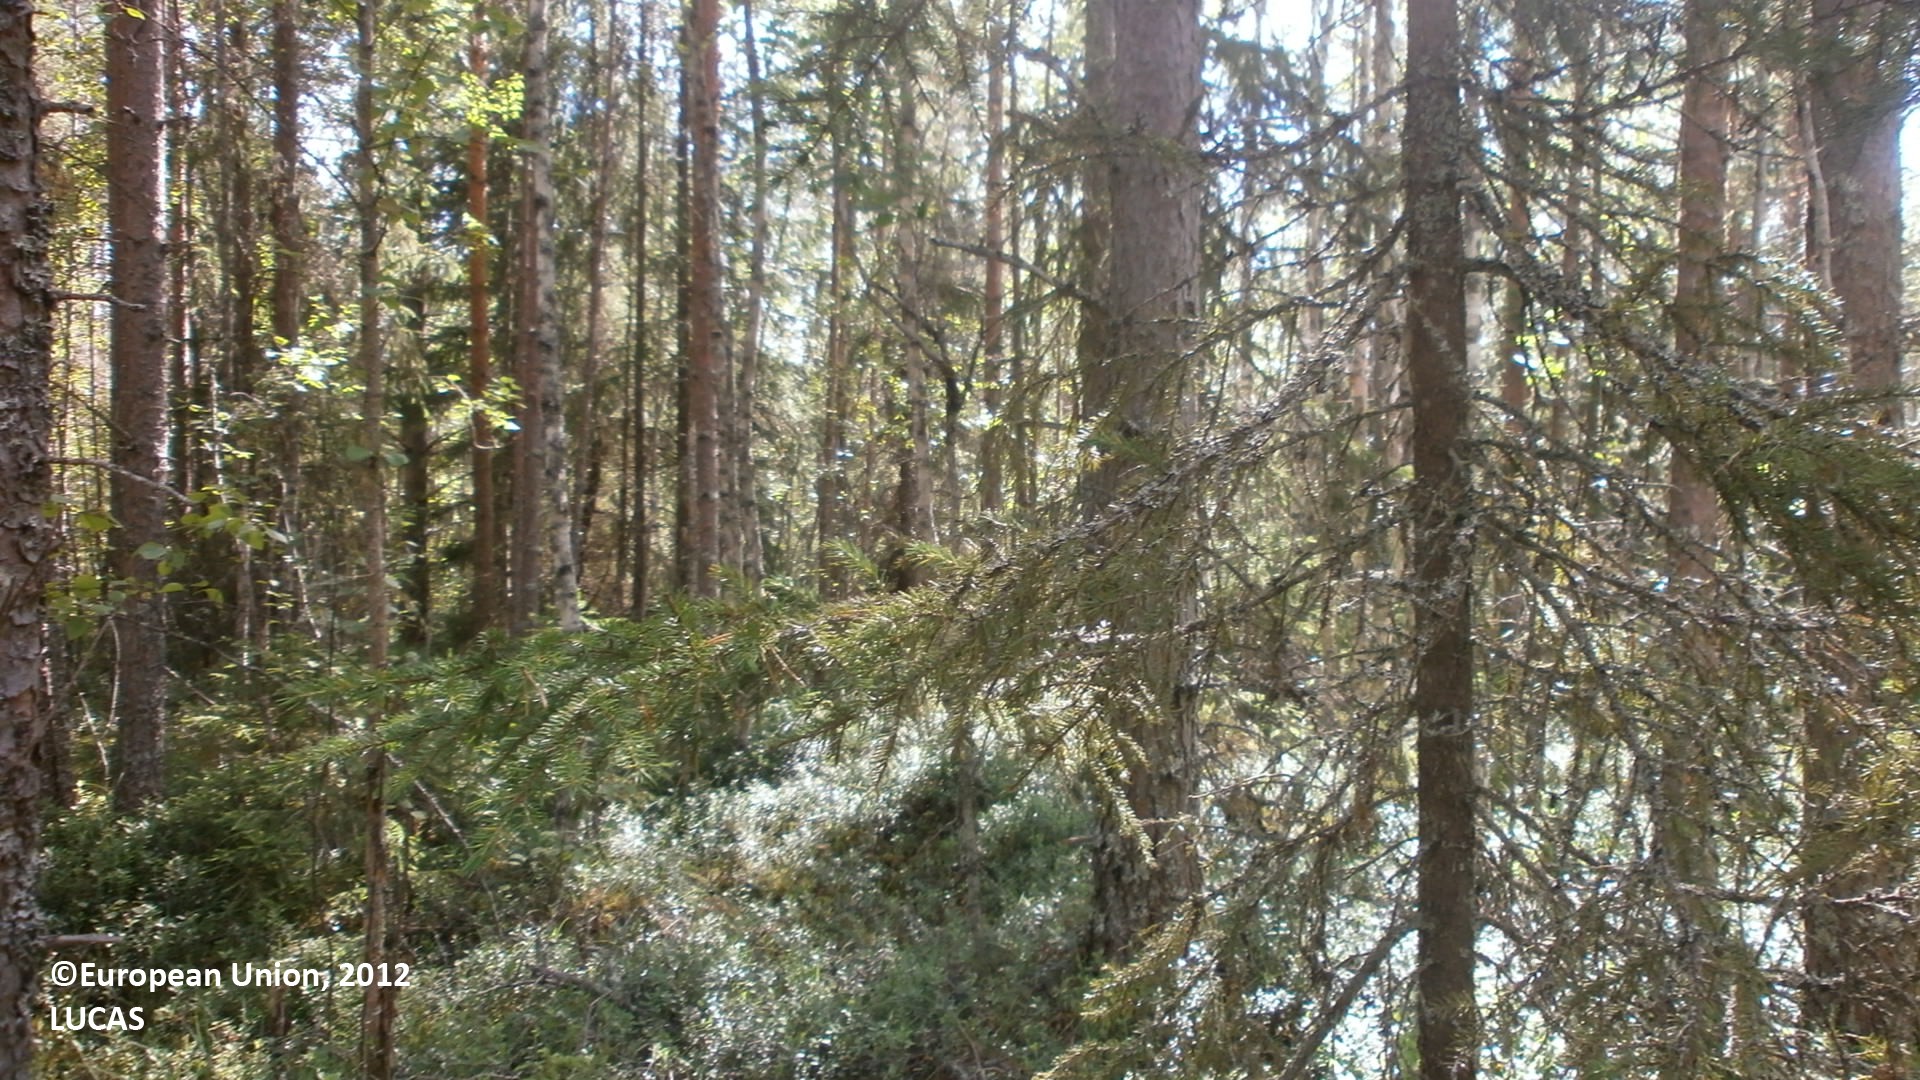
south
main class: Woodland
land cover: Pine dominated coniferous woodland
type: boreal forest
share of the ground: 50 - 75 %
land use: Forestry
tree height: > 5 m
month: July
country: FI
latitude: 63.9851
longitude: 23.8983
